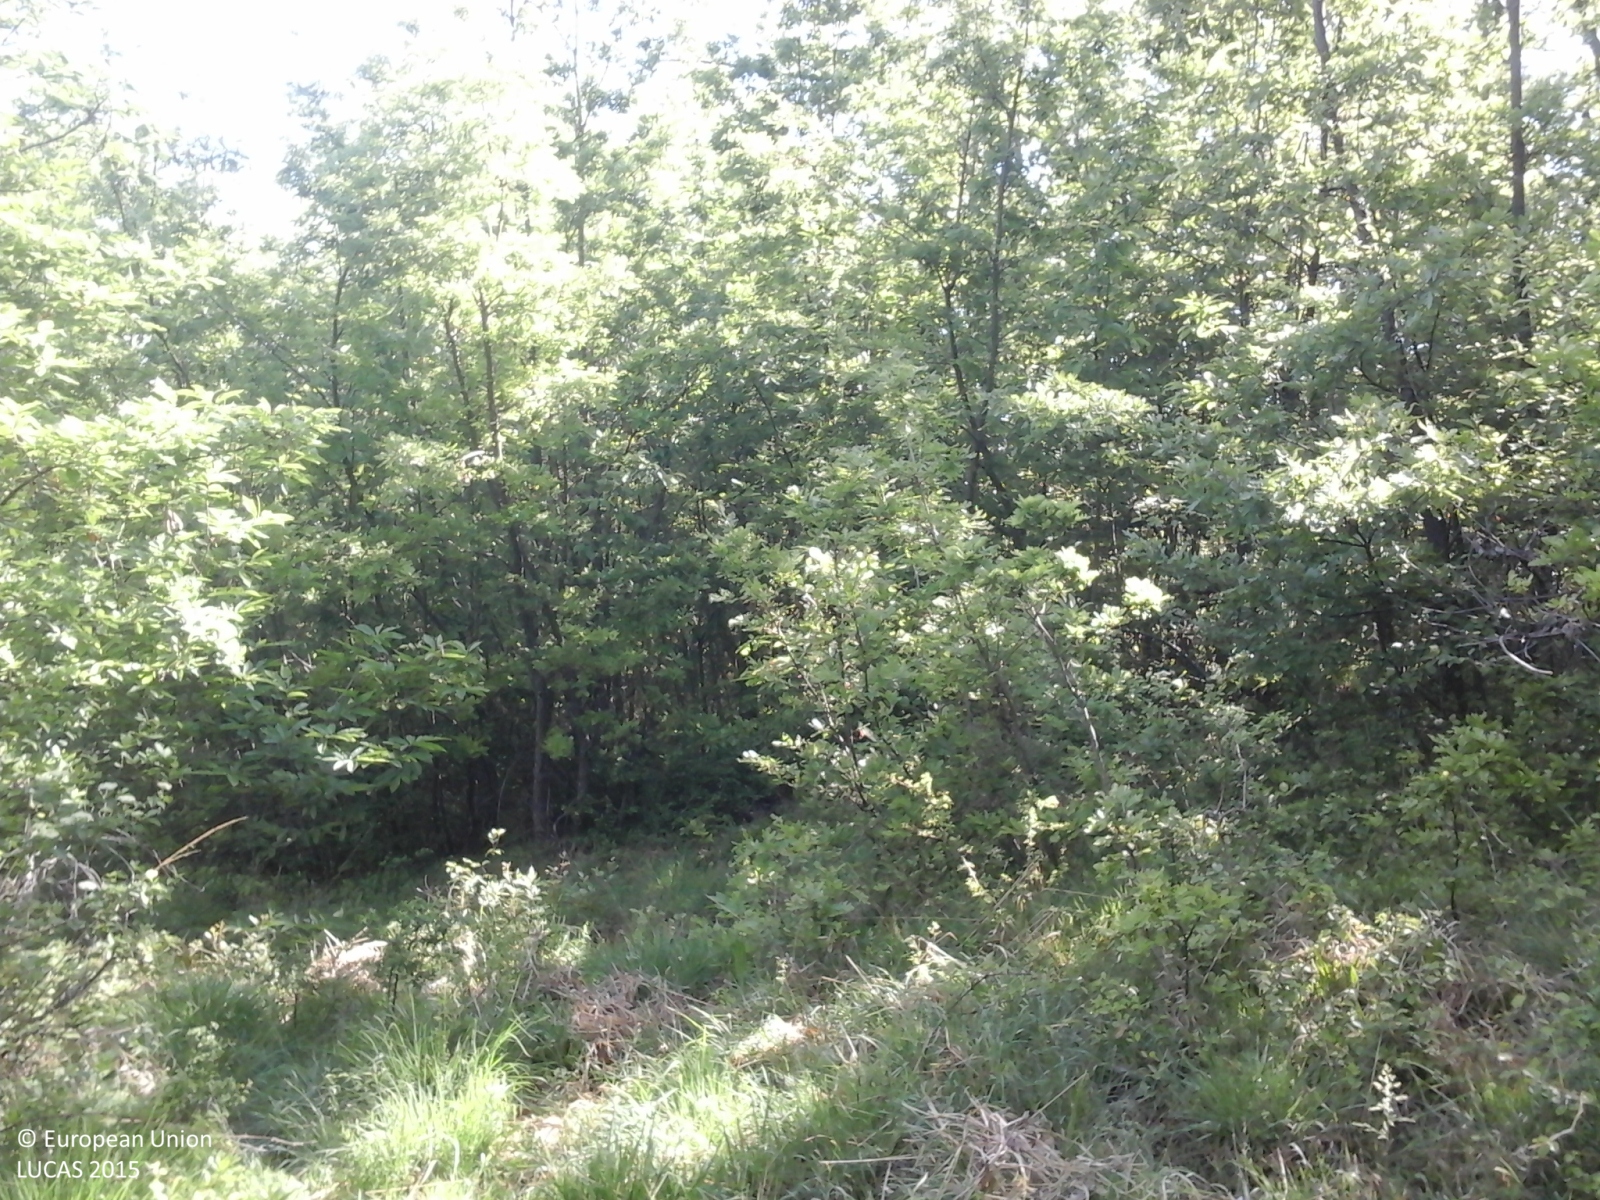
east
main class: Woodland
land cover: Broadleaved woodland
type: mesophytic deciduous forest
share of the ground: > 75 %
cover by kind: broadleaved forest trees 90 %, shrubs 5 %, herbaceous plants 5 %
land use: Forestry
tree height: > 5 m
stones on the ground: < 10 %
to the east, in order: Broadleaved woodland; Tracks; Broadleaved woodland
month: May
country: IT
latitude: 44.4582
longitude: 9.6614
